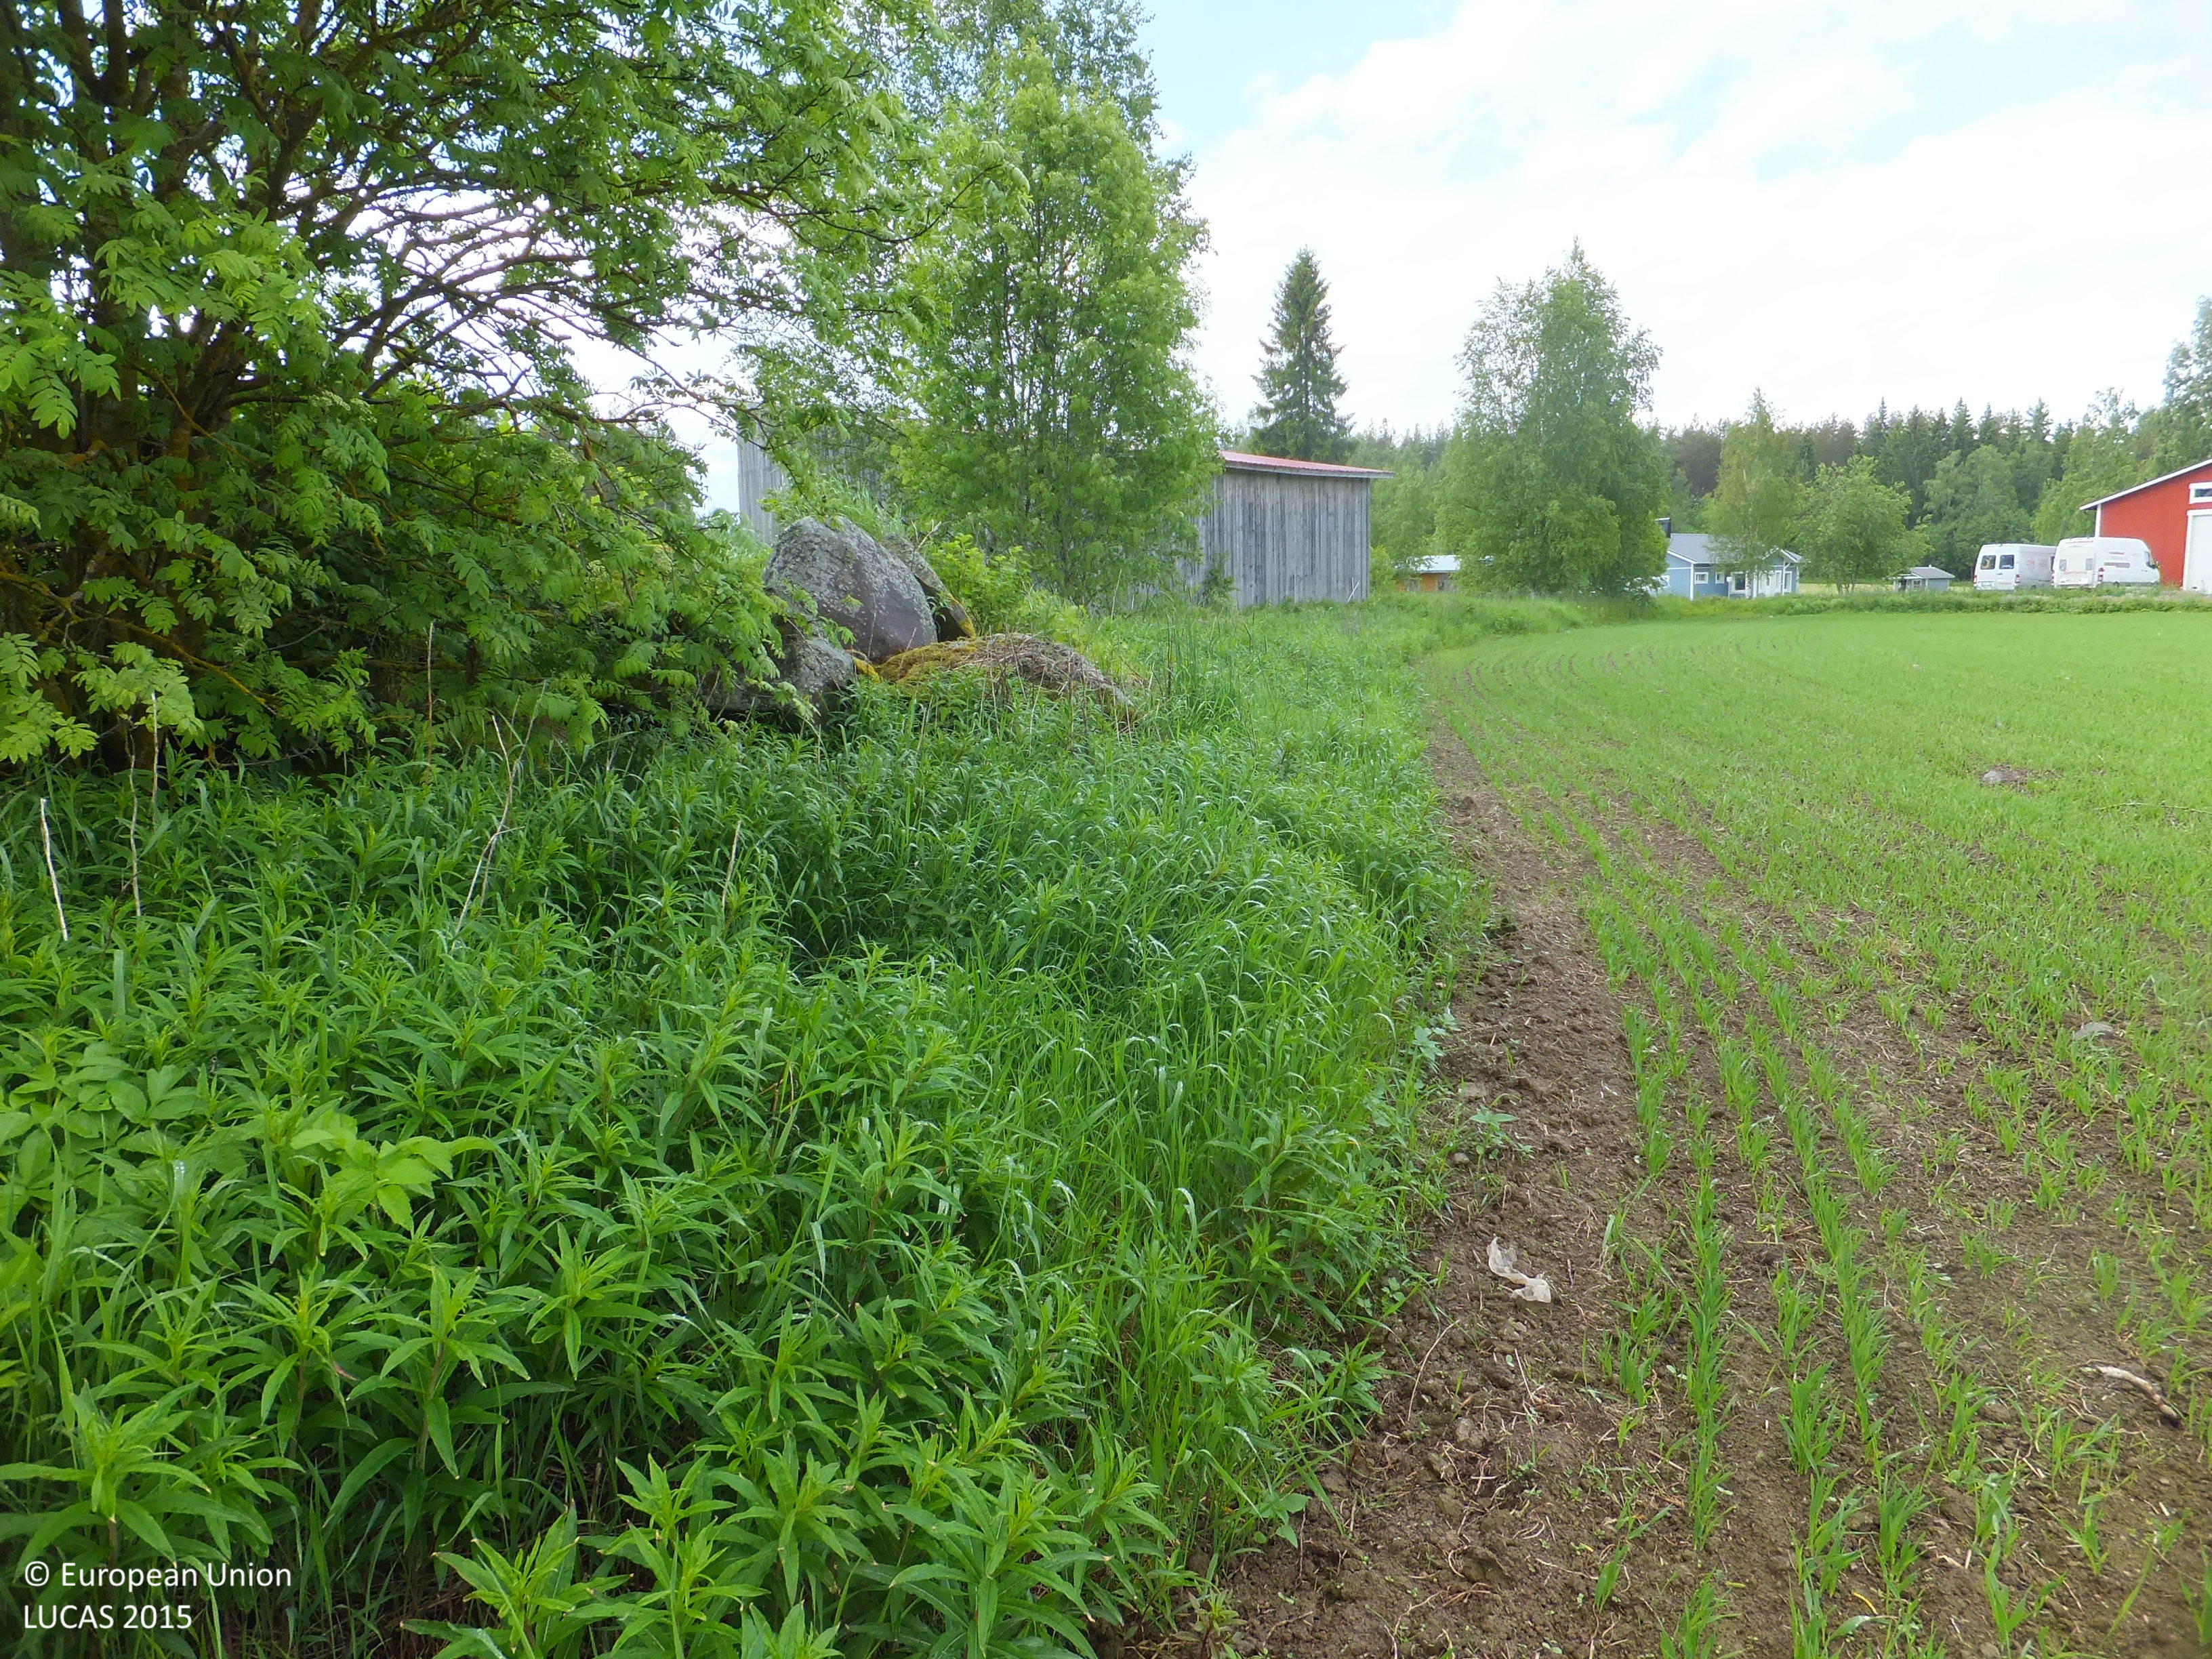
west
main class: Cropland
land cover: Barley
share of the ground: > 75 %
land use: Agriculture (excluding fallow land and kitchen gardens)
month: June
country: FI
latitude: 63.6165
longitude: 25.0769
